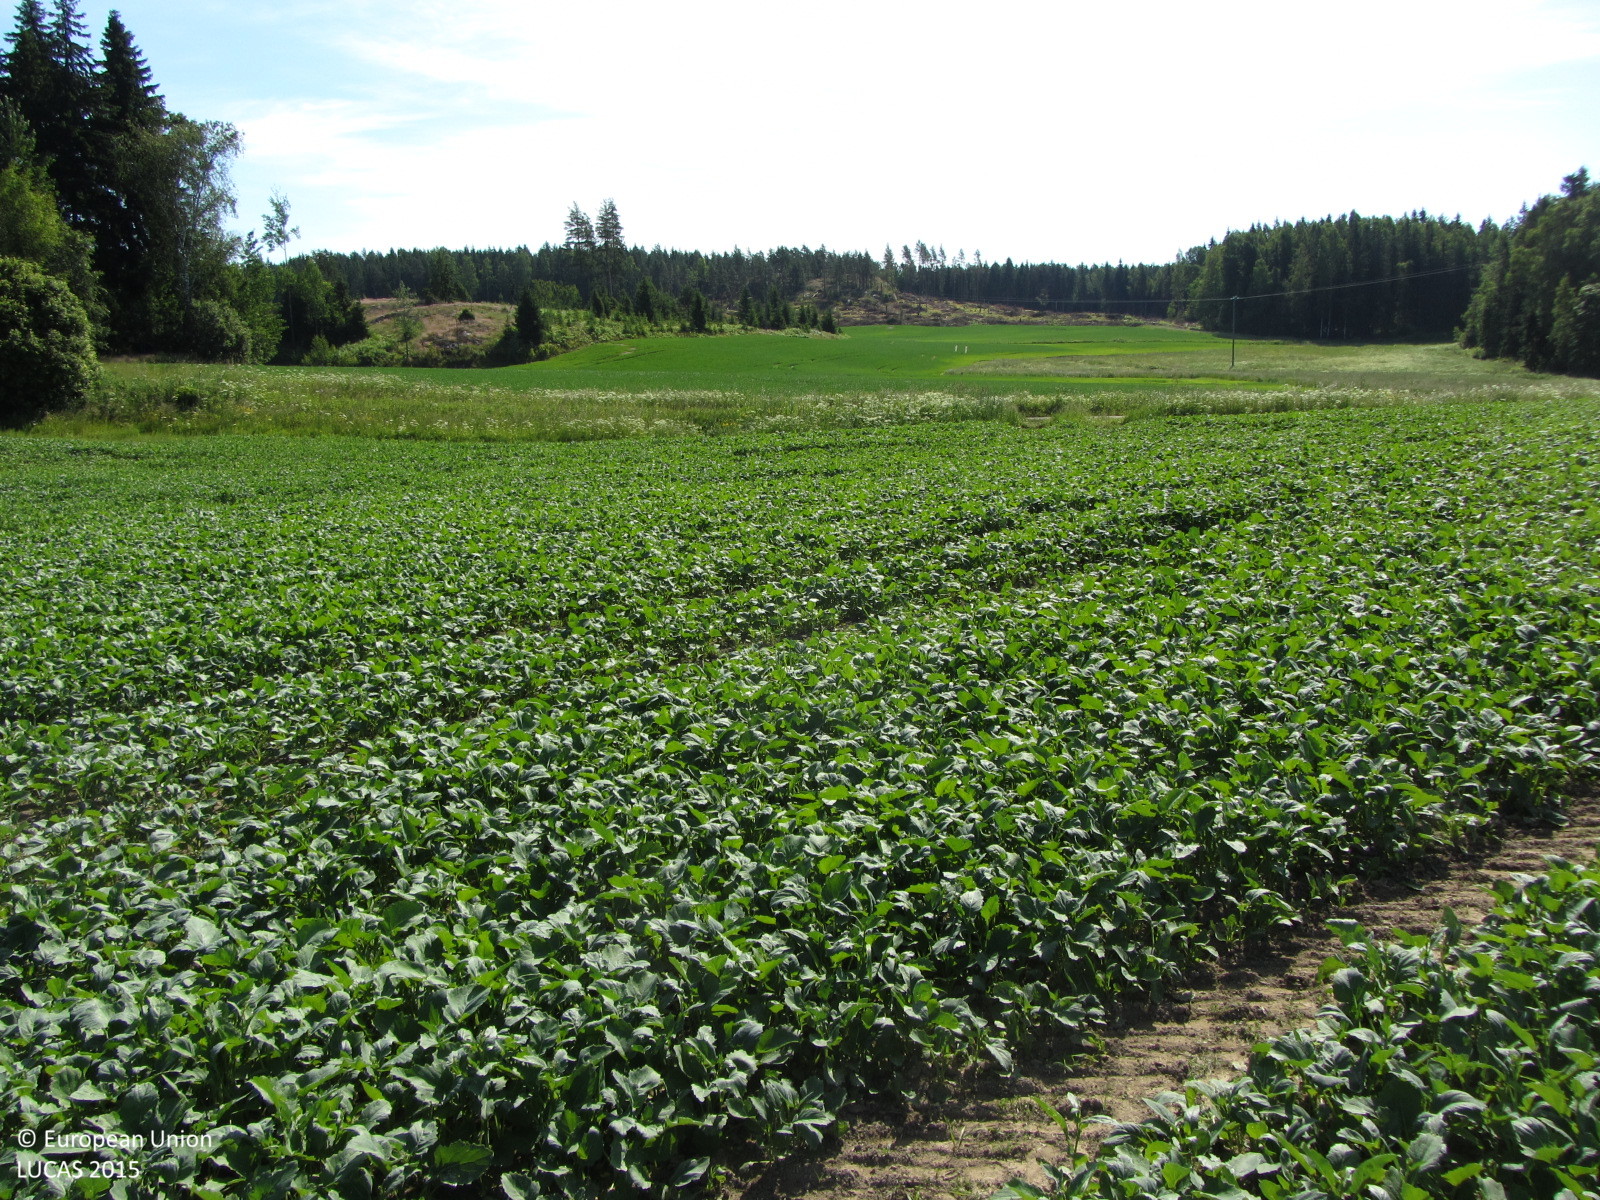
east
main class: Cropland
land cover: Other root crops
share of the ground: > 75 %
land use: Agriculture (excluding fallow land and kitchen gardens)
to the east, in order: Other root crops; Grass margins; Ditches and canals; Grass margins; Paved roads, cycling and walking lanes; Grass margins; Barley; Grassland with sparse tree/shrub cover; Electric lines; Pine dominated mixed woodland
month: July
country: FI
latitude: 60.0889
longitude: 23.3732
